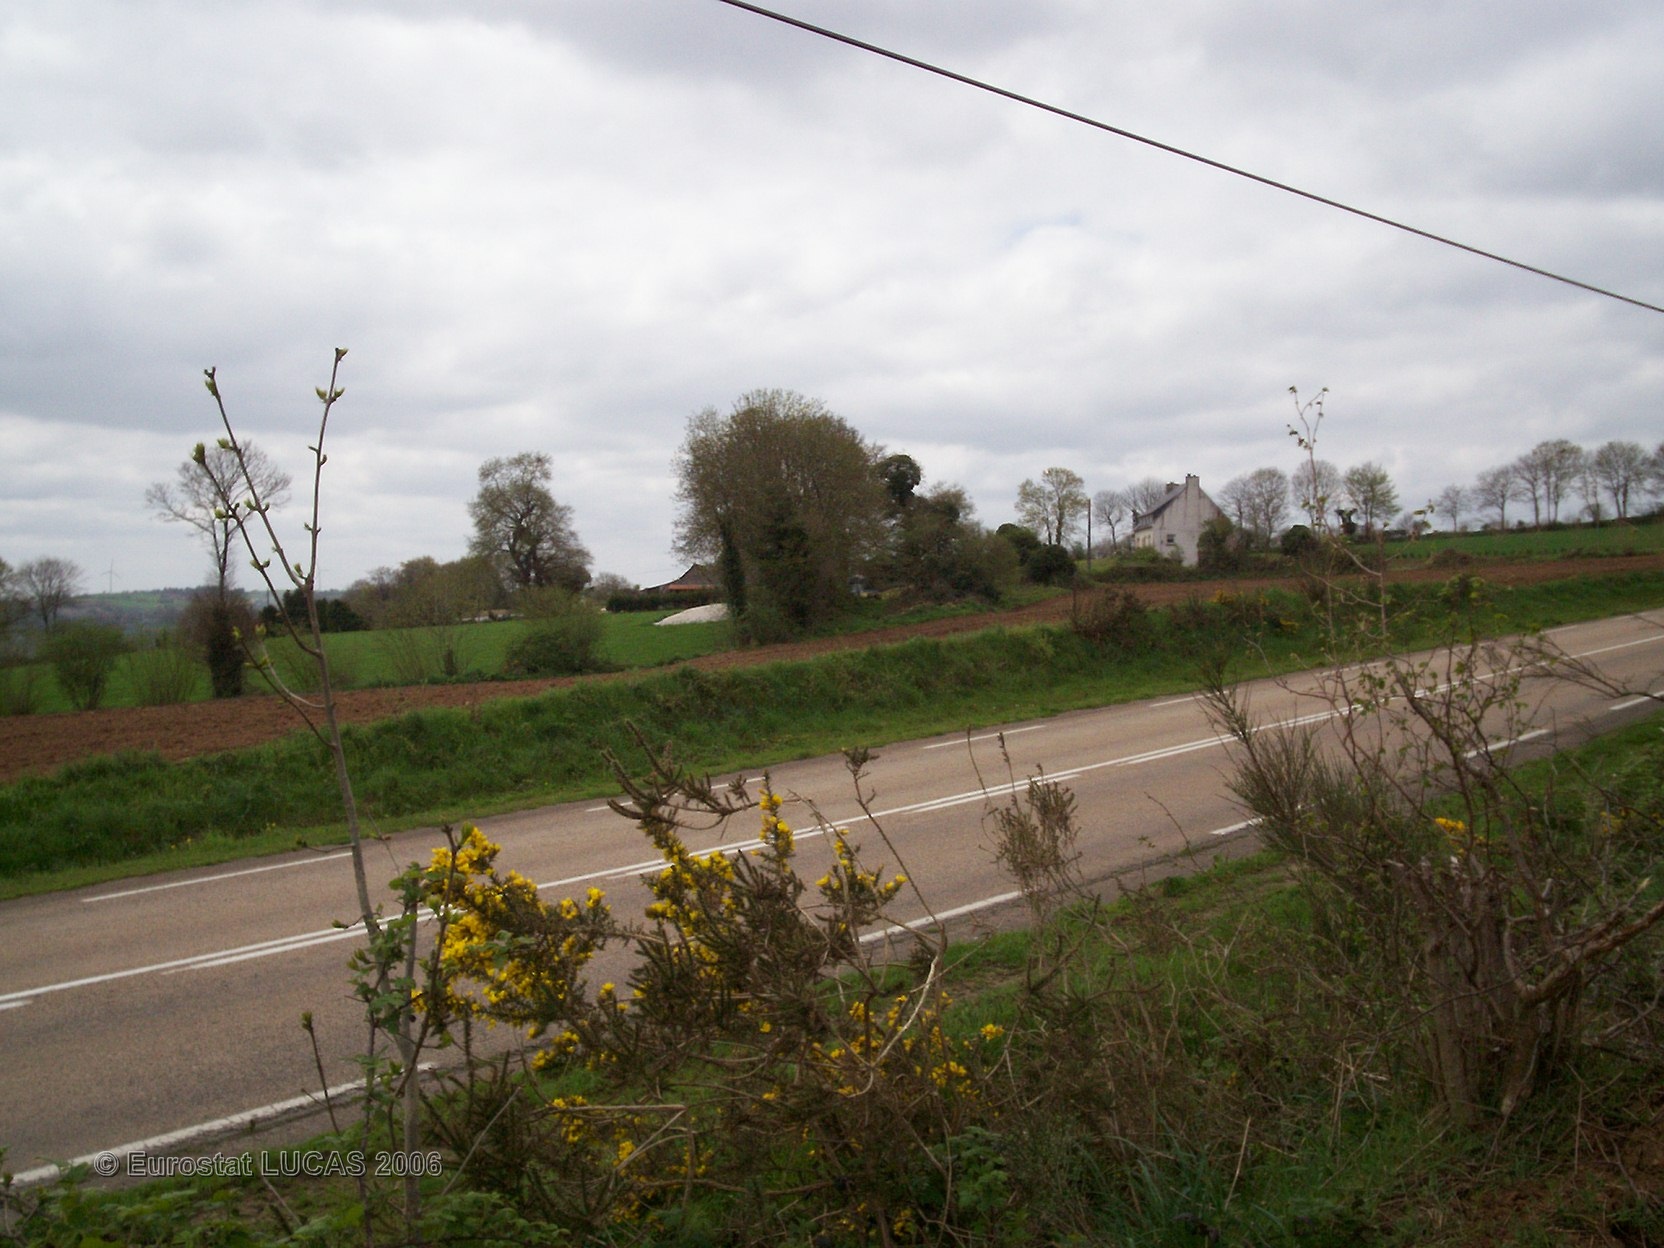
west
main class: Cropland
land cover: Maize
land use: Agriculture (excluding fallow land and kitchen gardens)
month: June
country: FR
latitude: 48.3456
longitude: -3.7238
